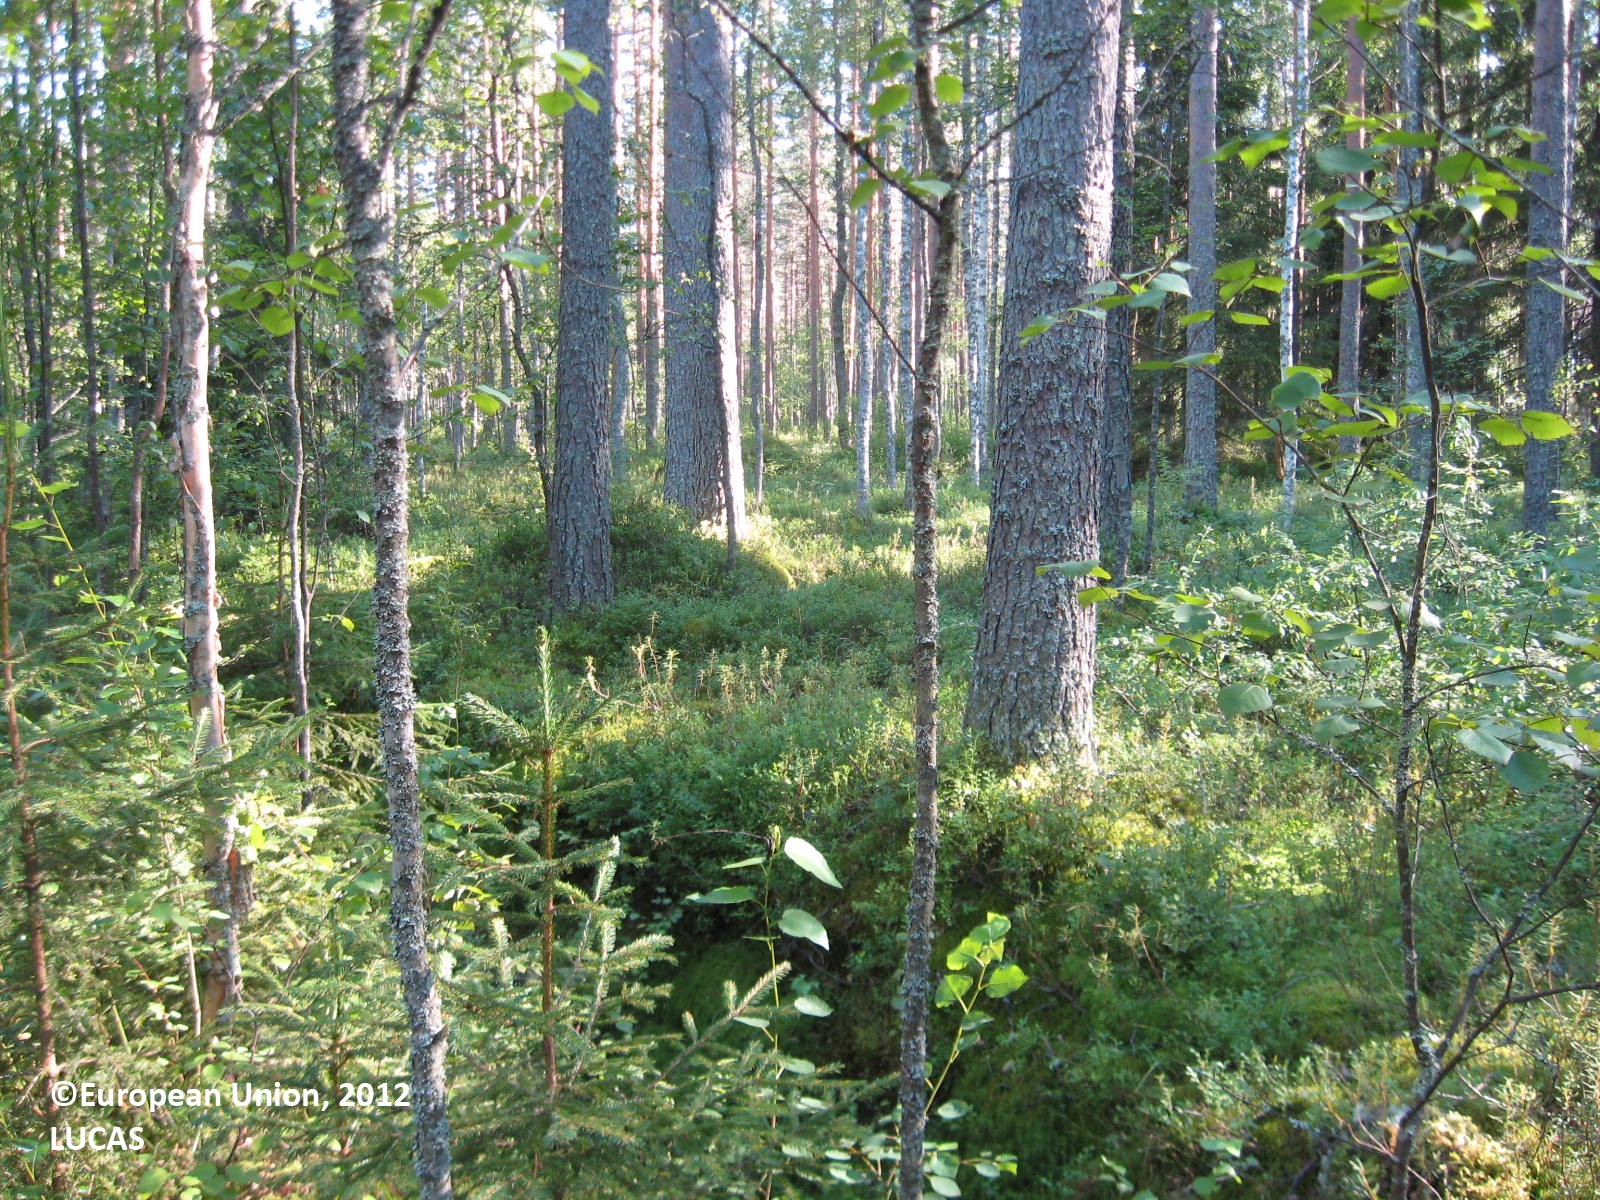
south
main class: Woodland
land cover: Pine dominated mixed woodland
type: boreal forest
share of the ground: > 75 %
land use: Forestry
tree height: > 5 m
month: July
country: FI
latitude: 62.0579
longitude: 22.4355
